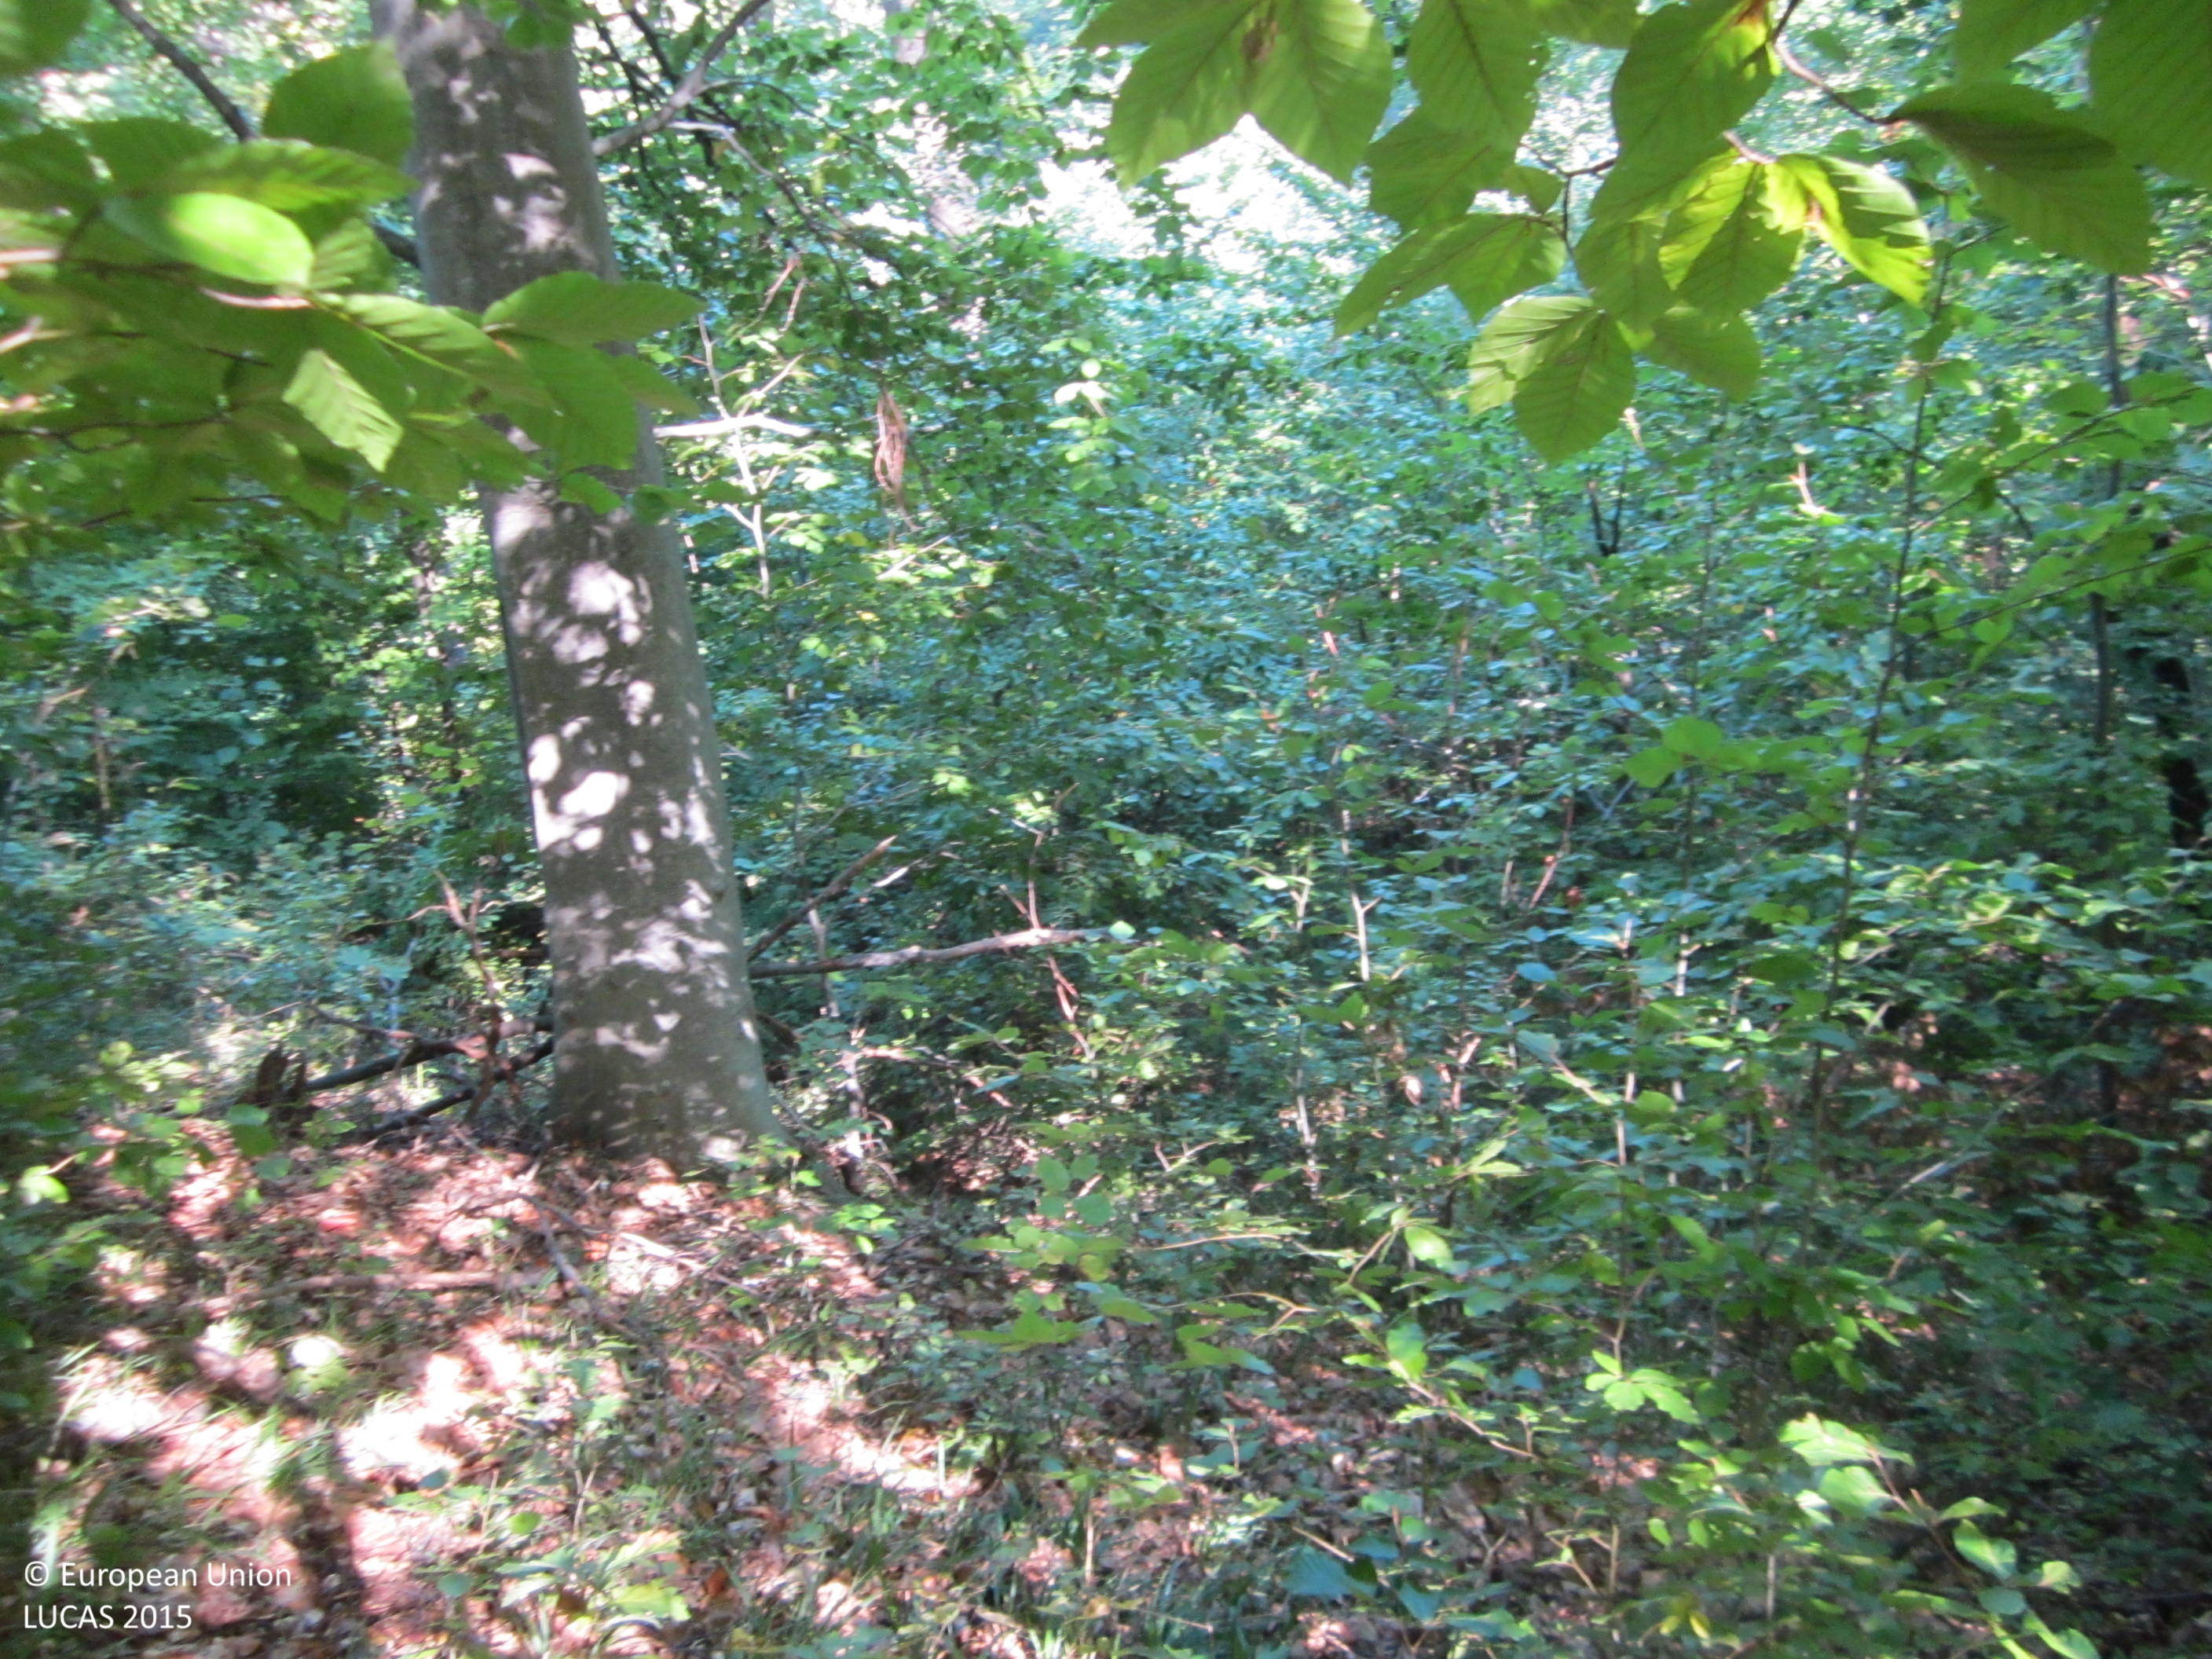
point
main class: Woodland
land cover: Broadleaved woodland
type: hemiboreal forest and nemoral coniferous forest and mixed broadleaved-coniferous forest
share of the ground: > 75 %
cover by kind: broadleaved forest trees 80 %, unconsolidated bare surface 10 %, shrubs 5 %, herbaceous plants 5 %
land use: Forestry
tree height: > 5 m
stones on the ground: < 10 %
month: October
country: BG
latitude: 42.9415
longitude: 26.6333
